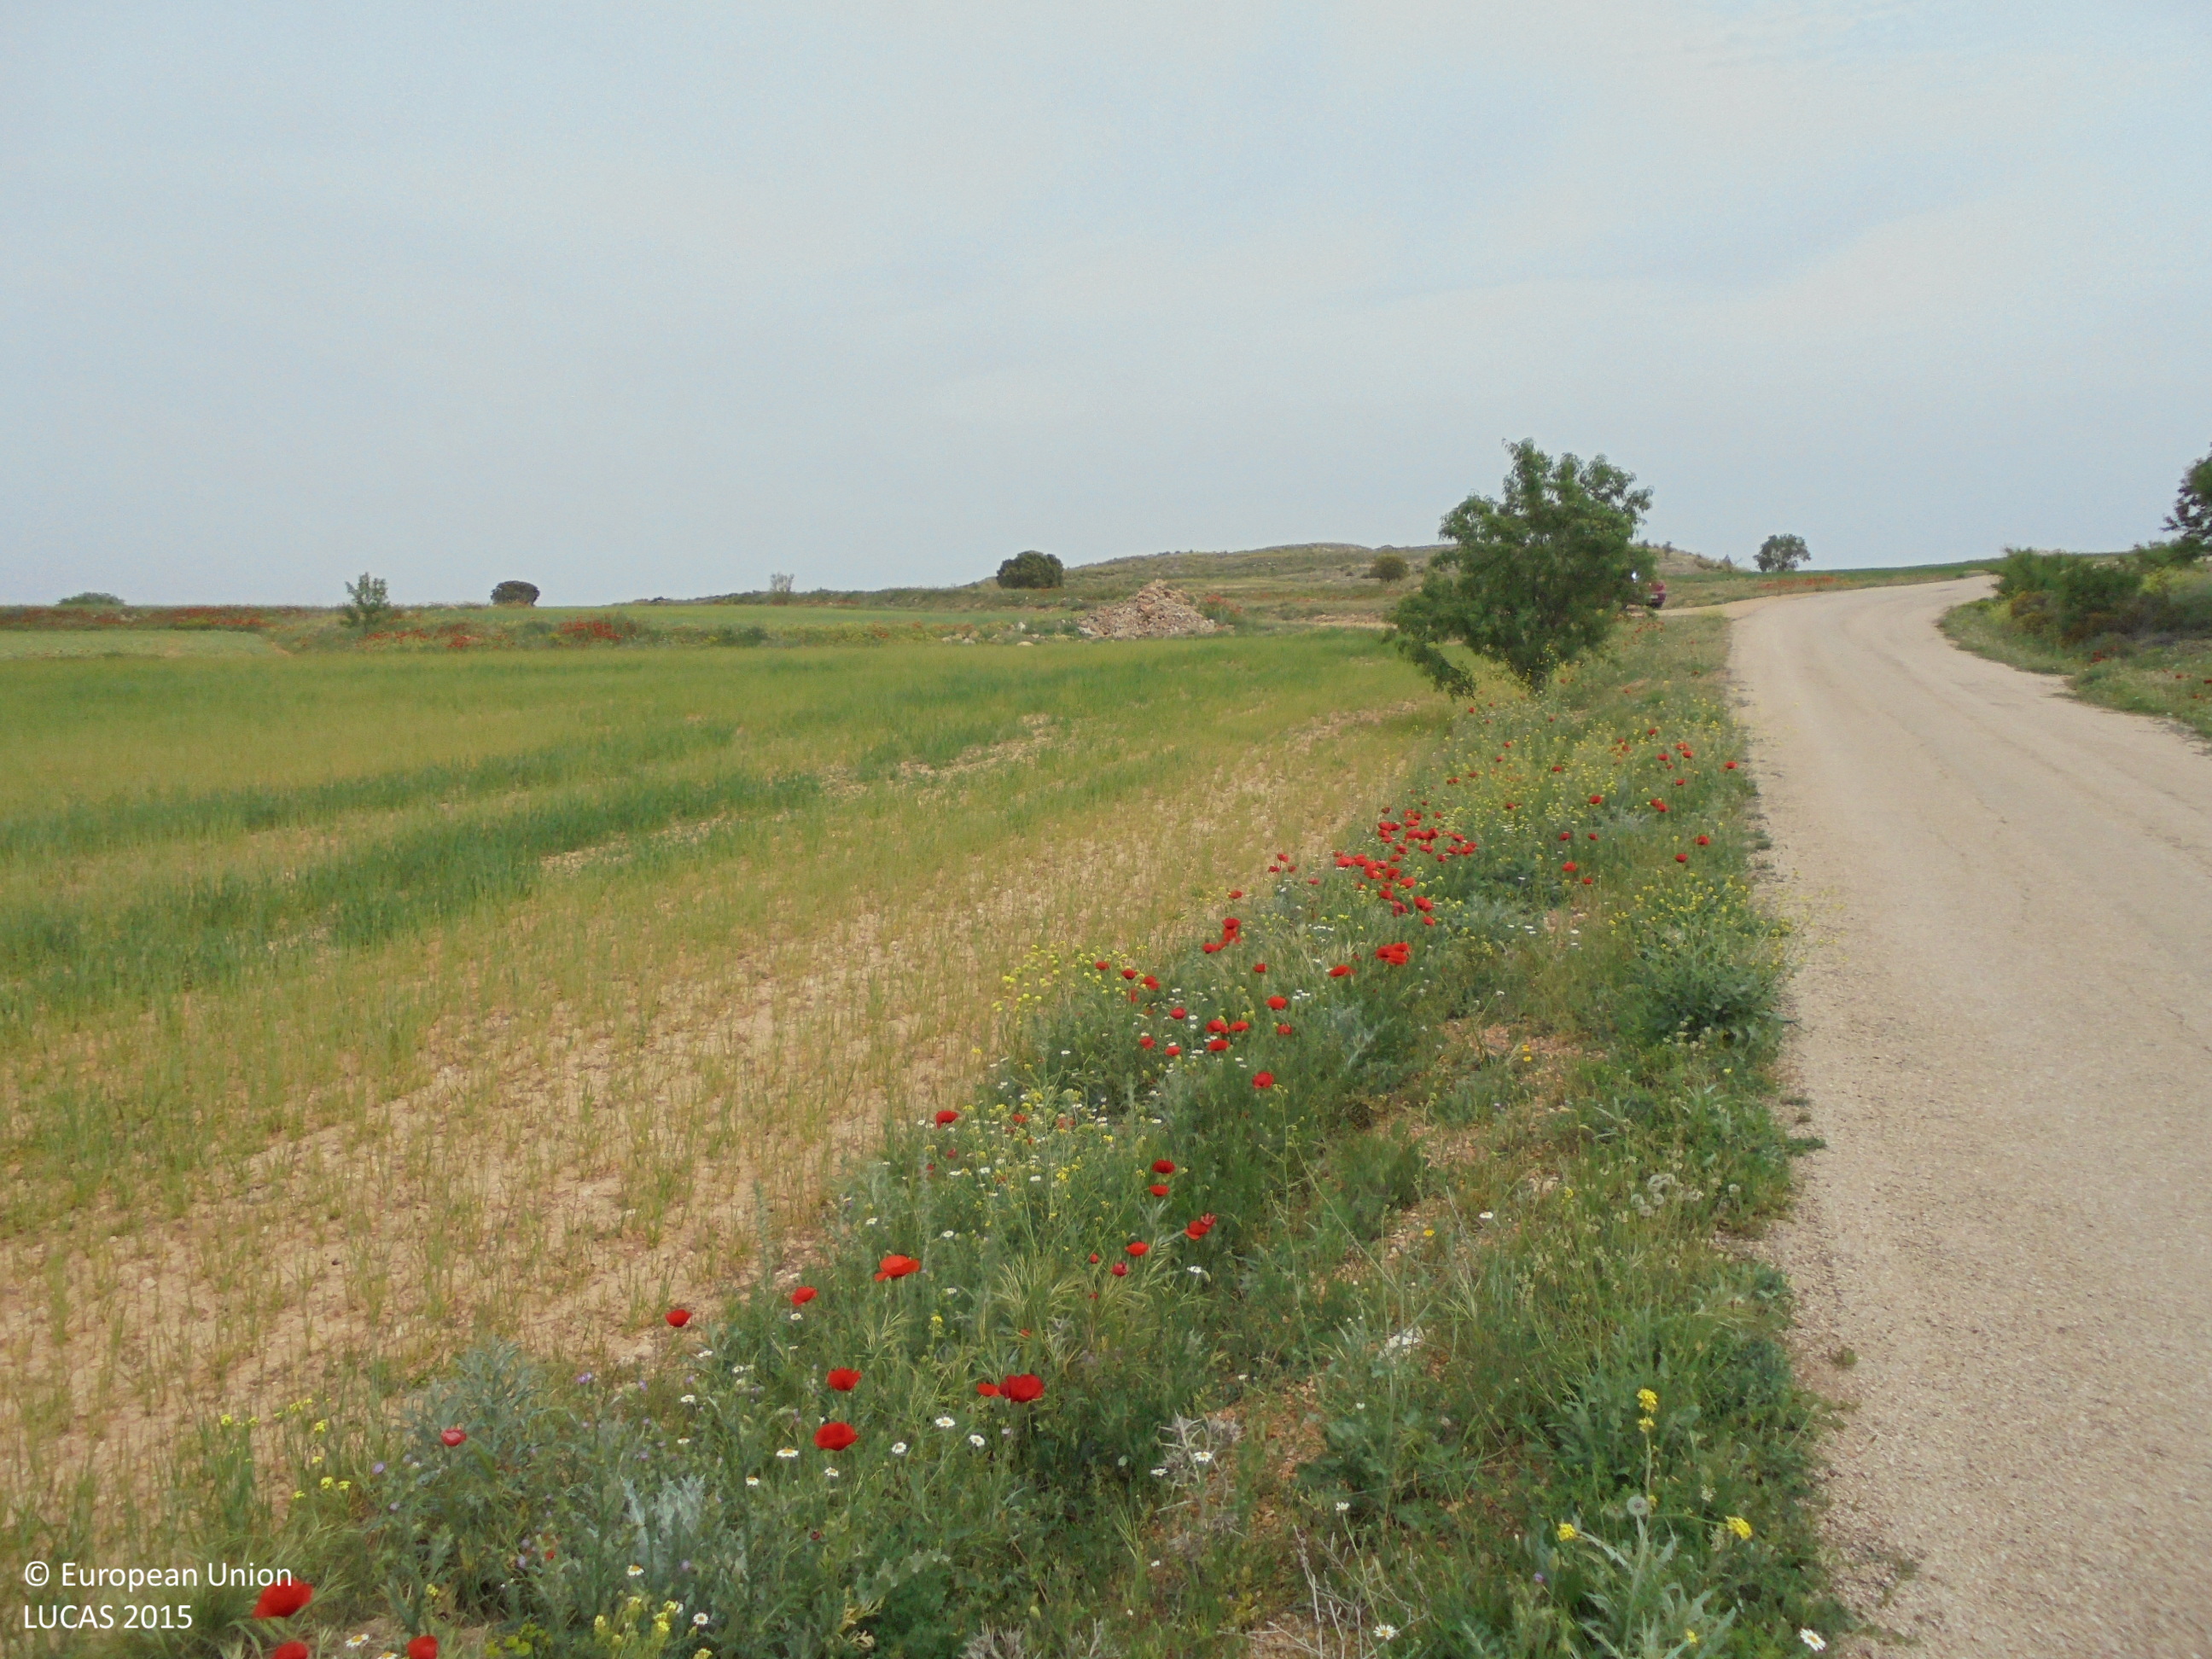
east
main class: Cropland
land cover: Barley
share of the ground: 25 - 50 %
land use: Agriculture (excluding fallow land and kitchen gardens)
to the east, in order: Grass margins; Barley; Grass margins; Tracks; Grass margins; Dry stone walls; Grass margins; Tracks; Grassland without tree/shrub cover; Spontaneously vegetated surfaces; Dry stone walls; Grass margins; Barley; Grassland without tree/shrub cover; Spontaneously vegetated surfaces; Grassland without tree/shrub cover; Spontaneously vegetated surfaces; Shrubland without tree cover
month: May
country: ES
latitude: 39.2424
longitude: -1.6462
